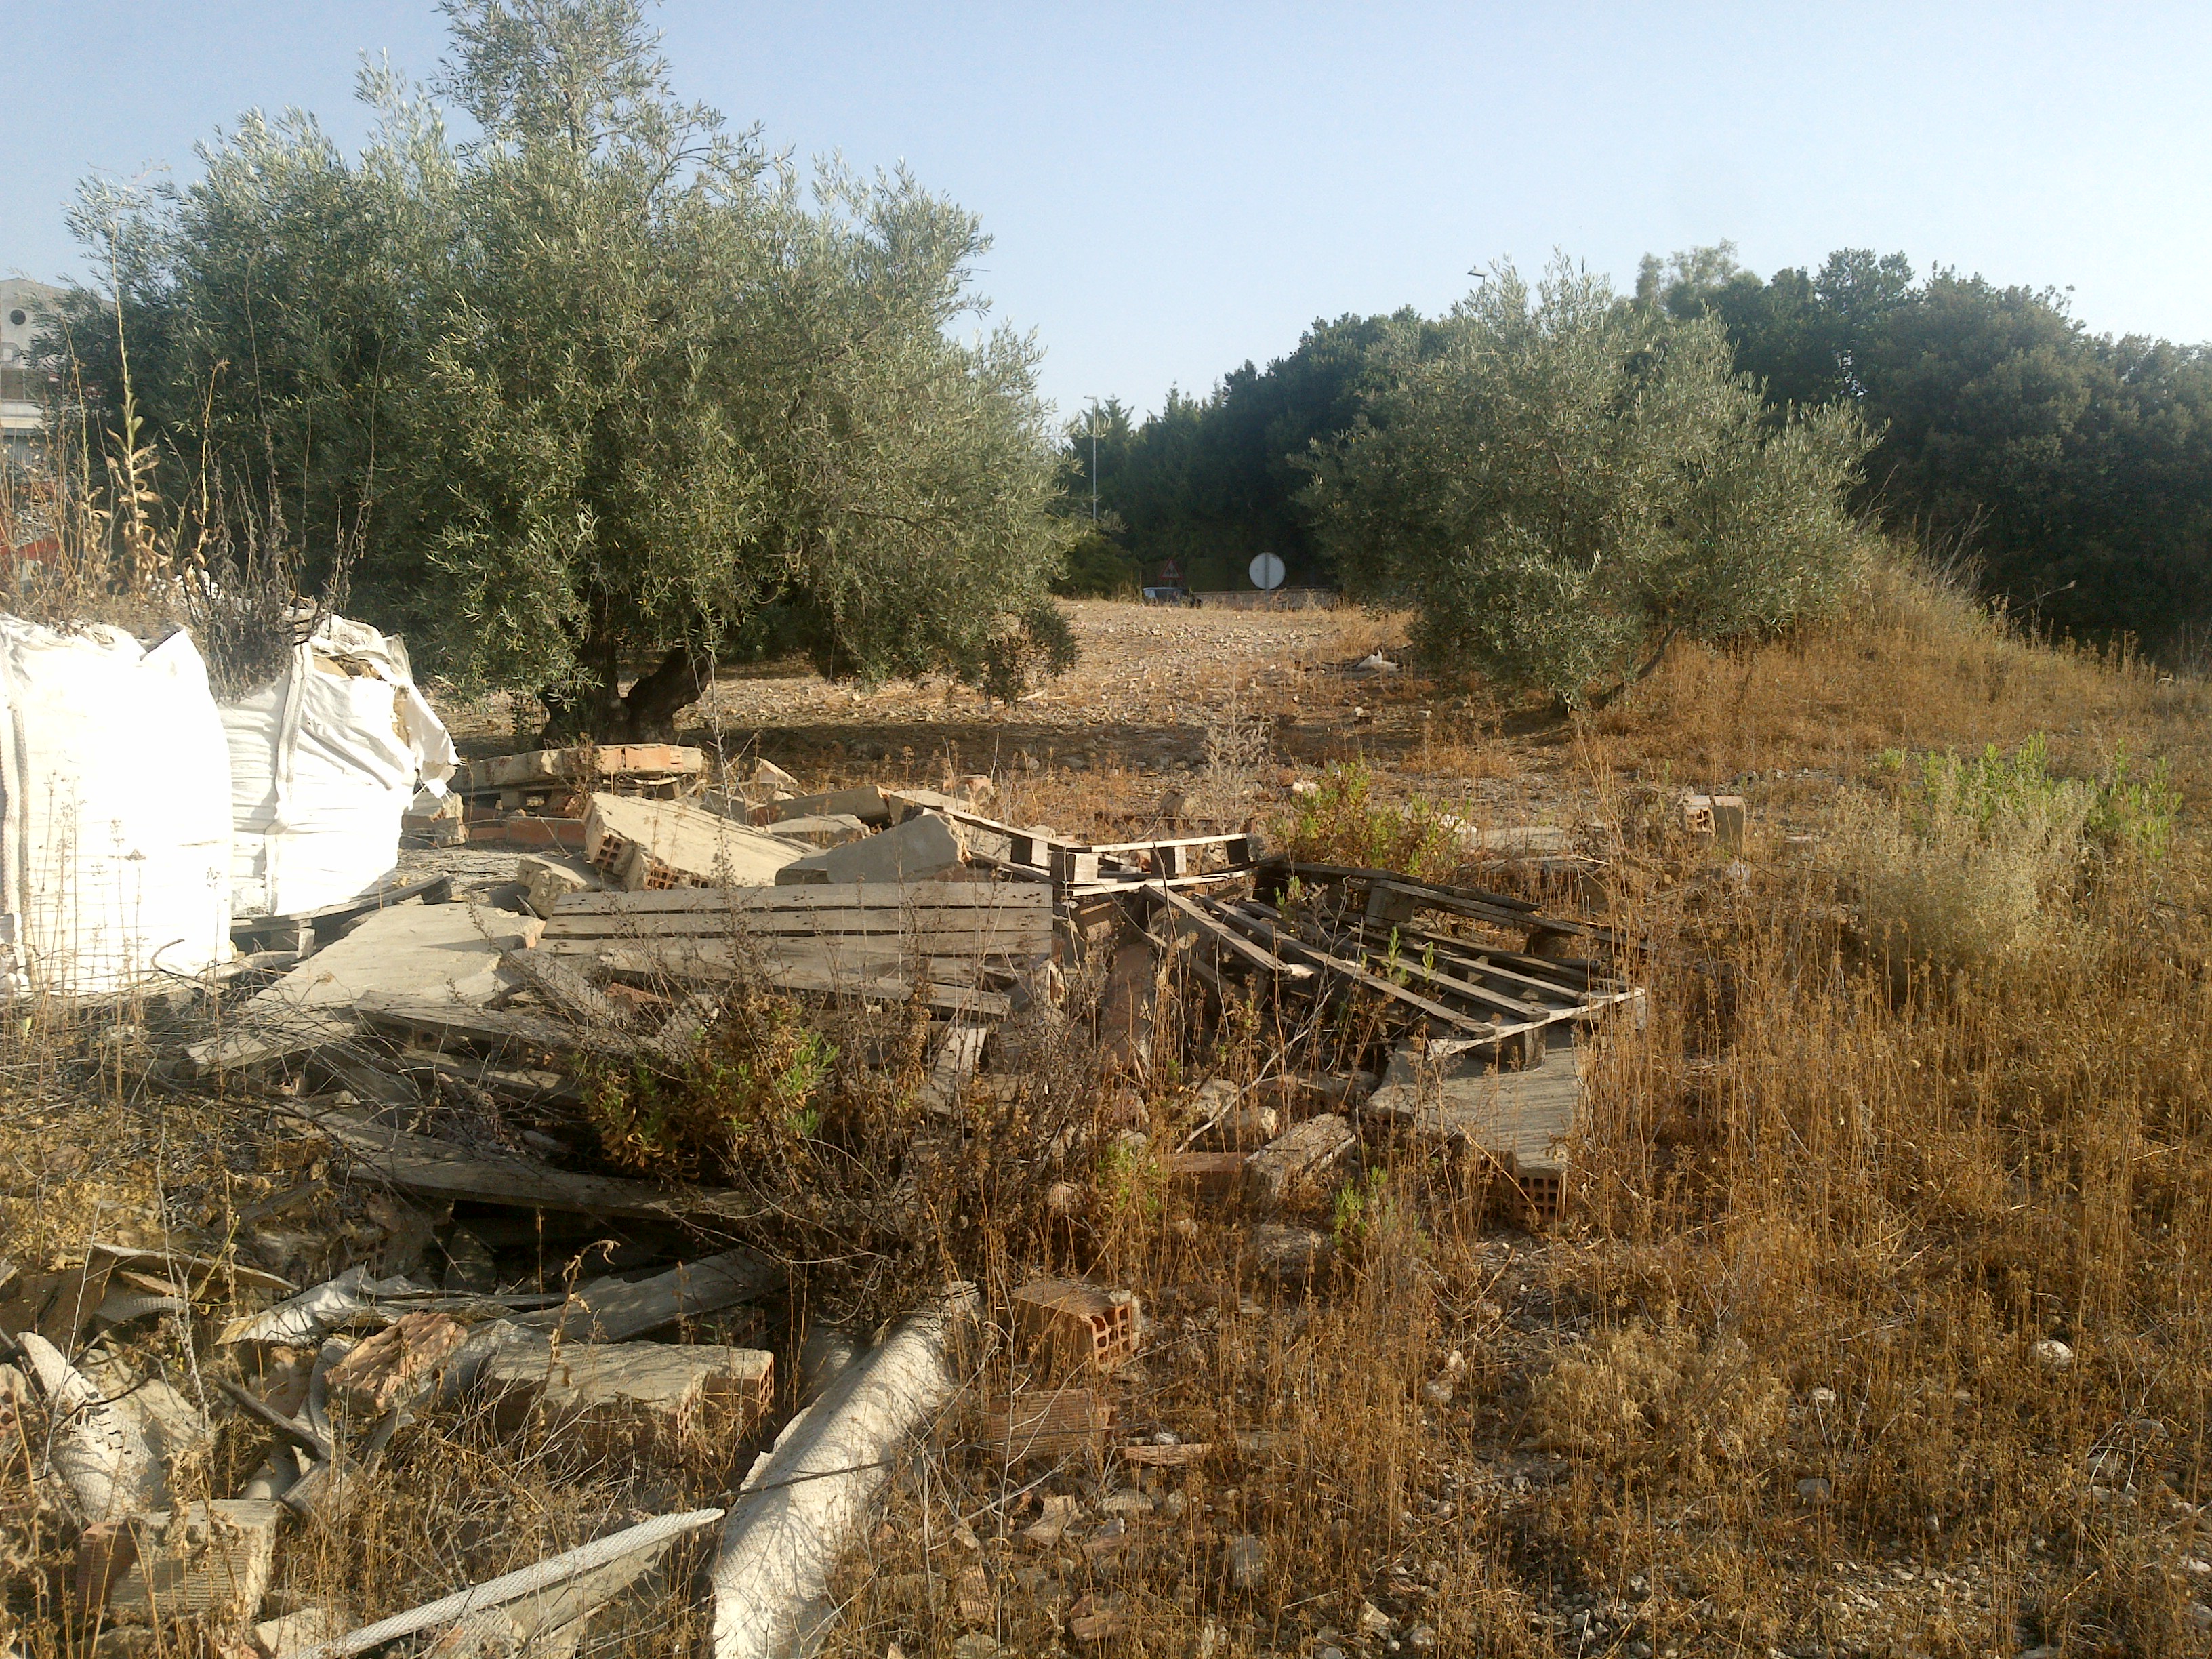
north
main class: Cropland
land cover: Olive groves
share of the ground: 25 - 50 %
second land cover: Spontaneously vegetated surfaces
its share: 25 - 50 %
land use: Agriculture (excluding fallow land and kitchen gardens)
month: July
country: ES
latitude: 37.3671
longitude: -4.4890
